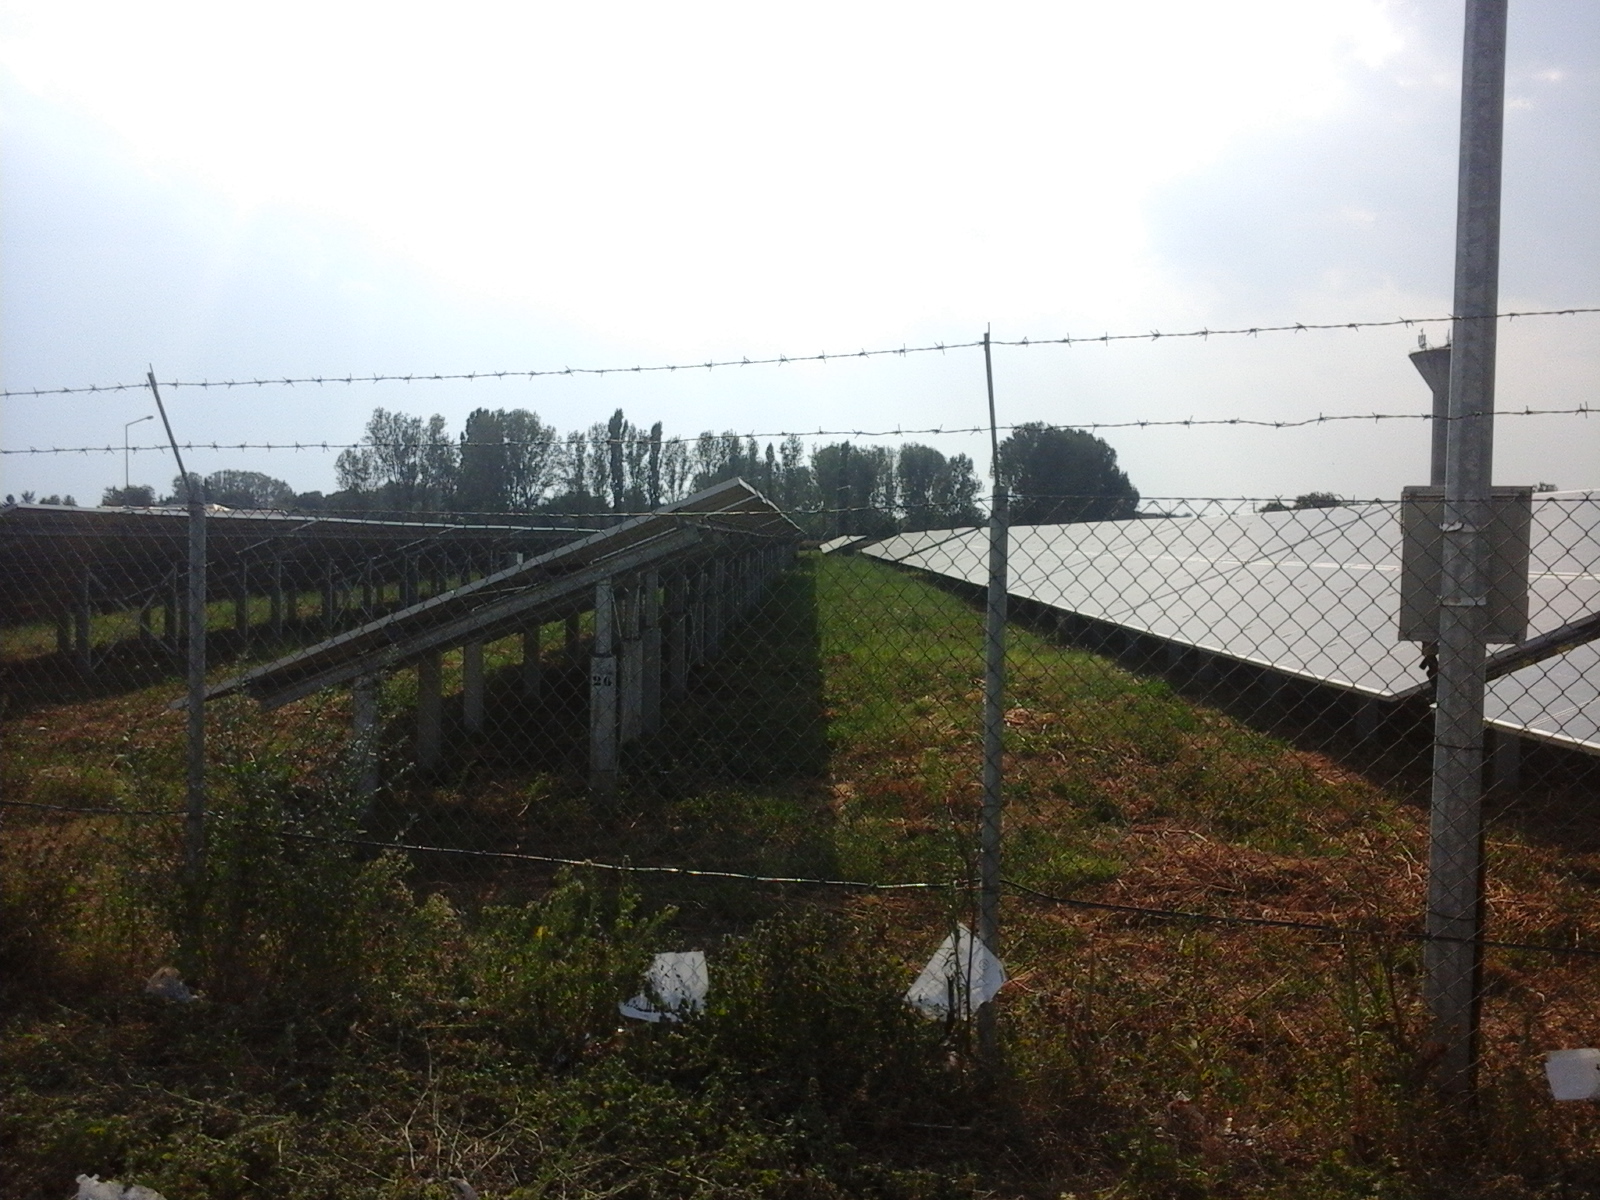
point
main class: Artificial land
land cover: Other artificial areas
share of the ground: > 75 %
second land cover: Grassland without tree/shrub cover
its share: > 75 %
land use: Electricity, gas and thermal power distribution
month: August
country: RO
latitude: 44.0301
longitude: 23.3603
